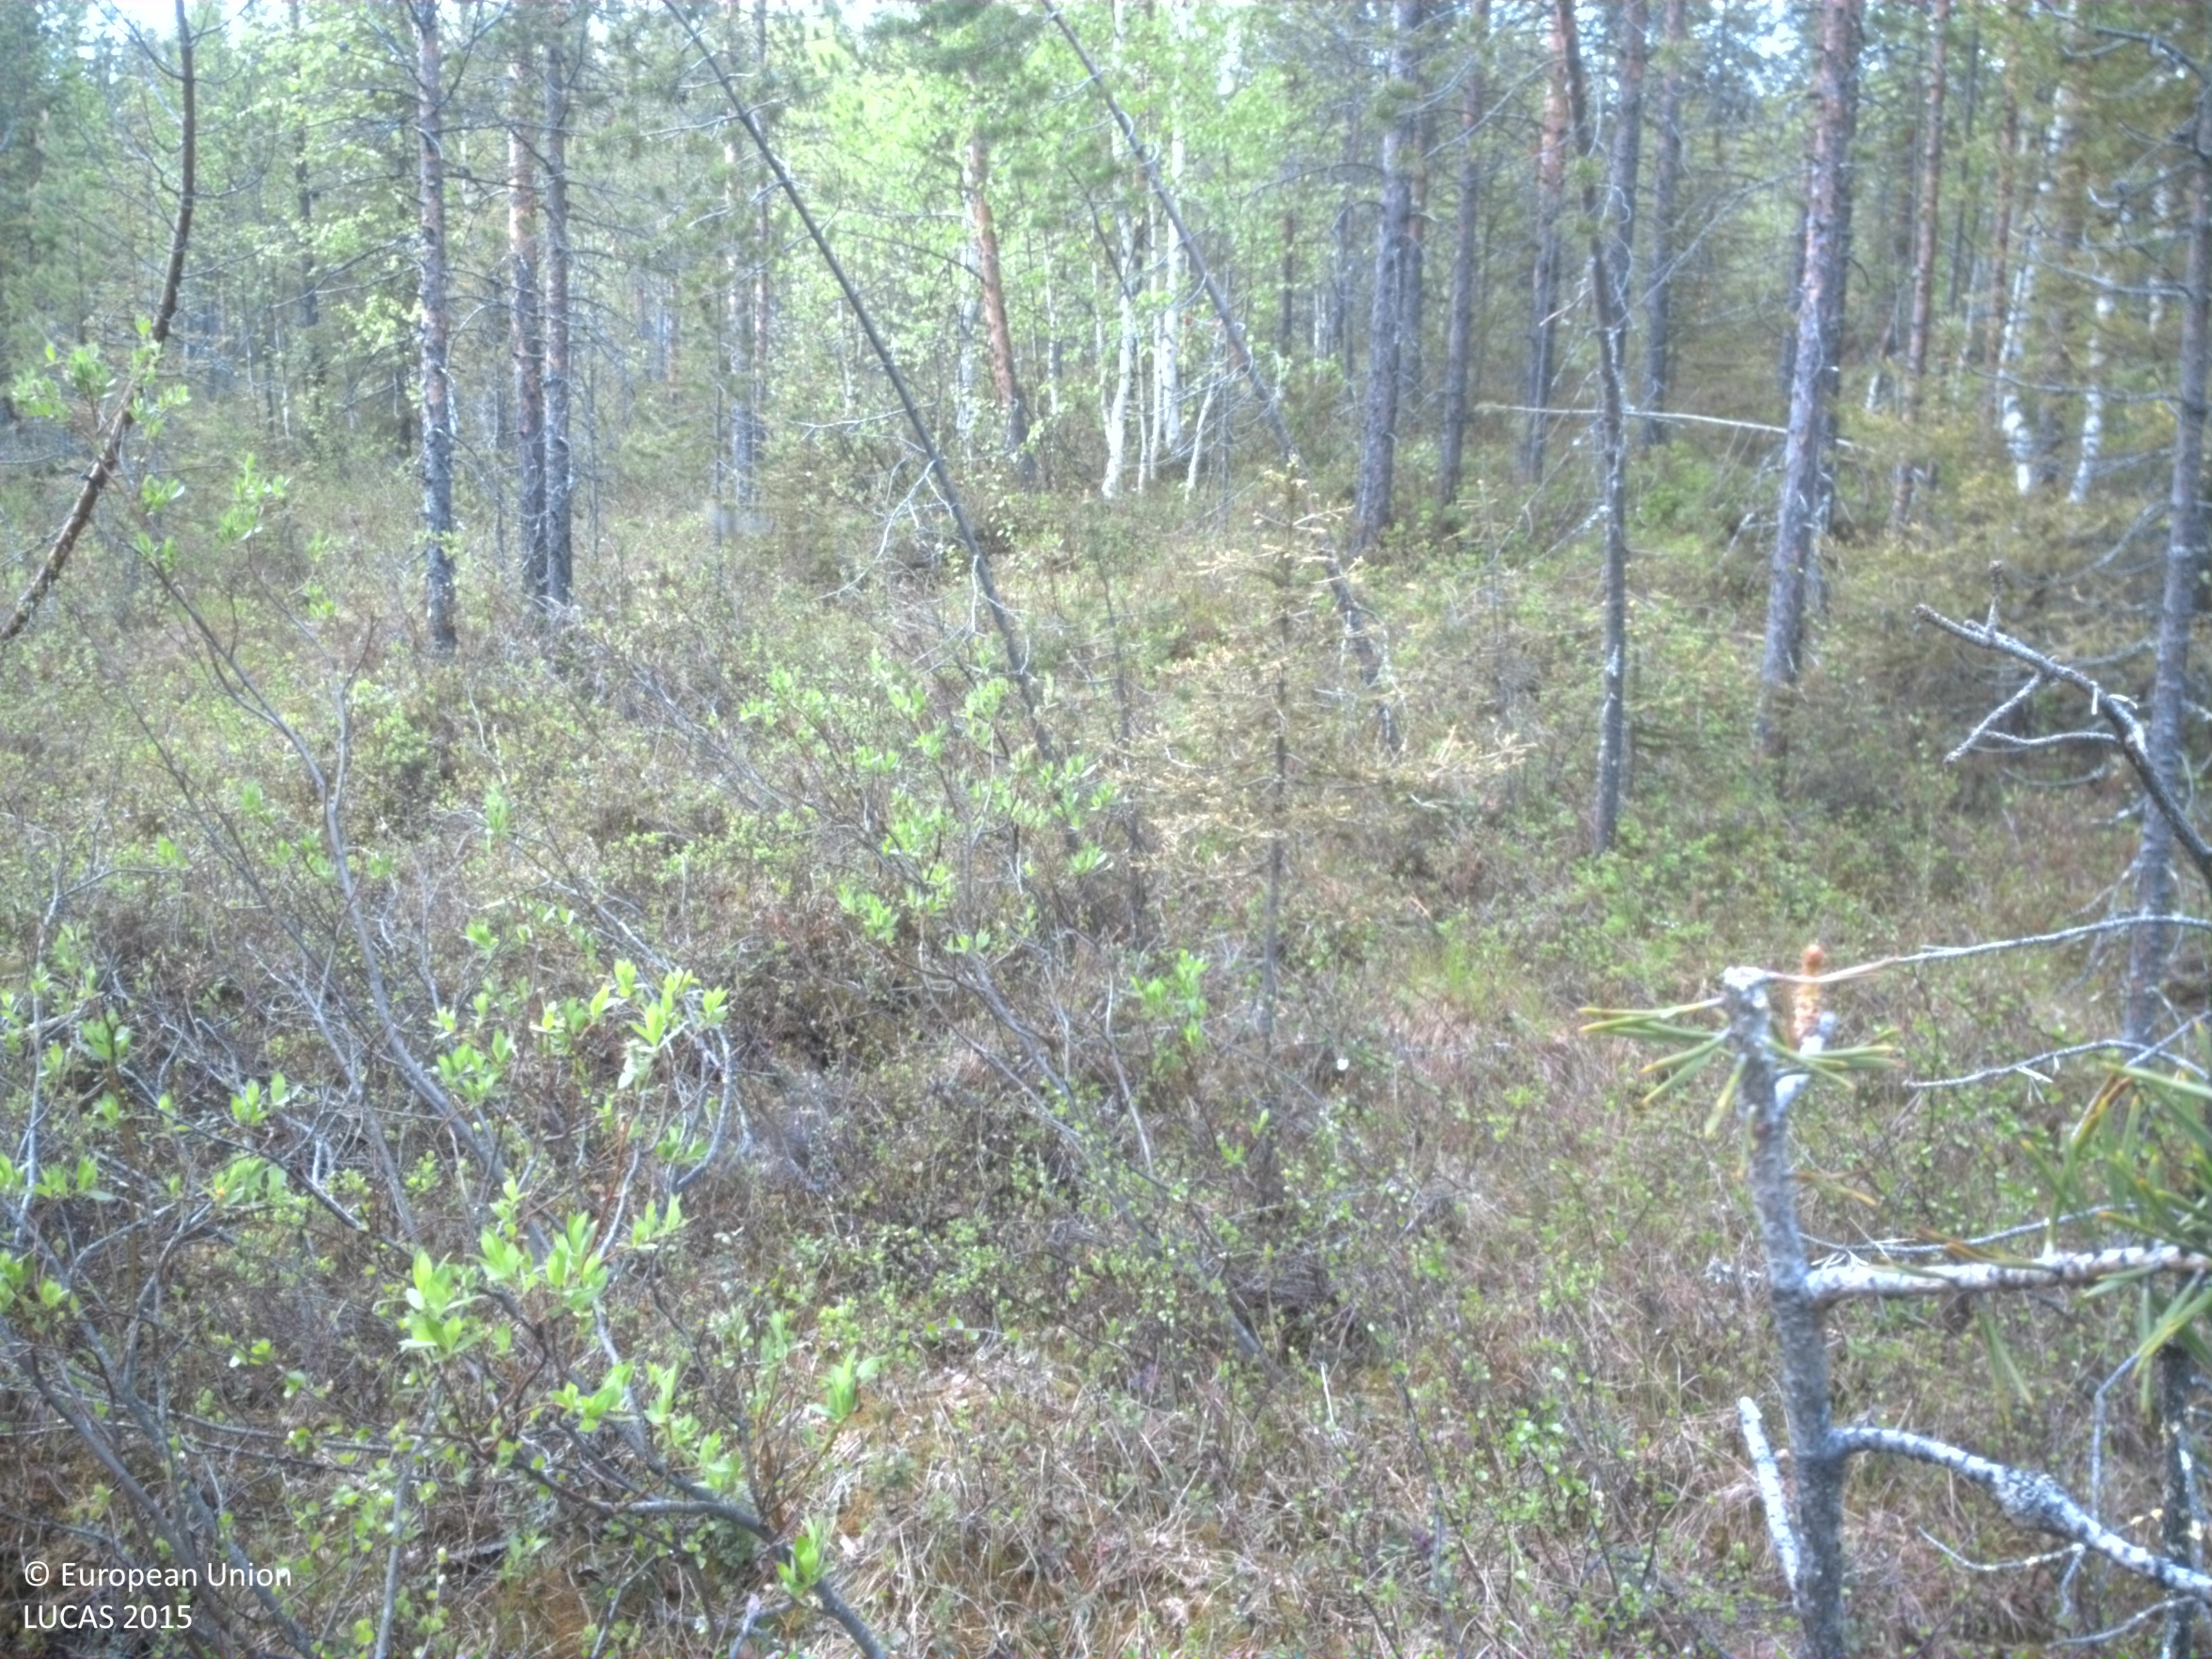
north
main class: Woodland
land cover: Pine dominated coniferous woodland
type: boreal forest
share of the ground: 25 - 50 %
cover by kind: shrubs 70 %, coniferous forest trees 20 %, broadleaved forest trees 5 %, lichens and mosses 5 %
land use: Forestry
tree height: > 5 m
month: June
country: SE
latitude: 66.9268
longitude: 21.7810
